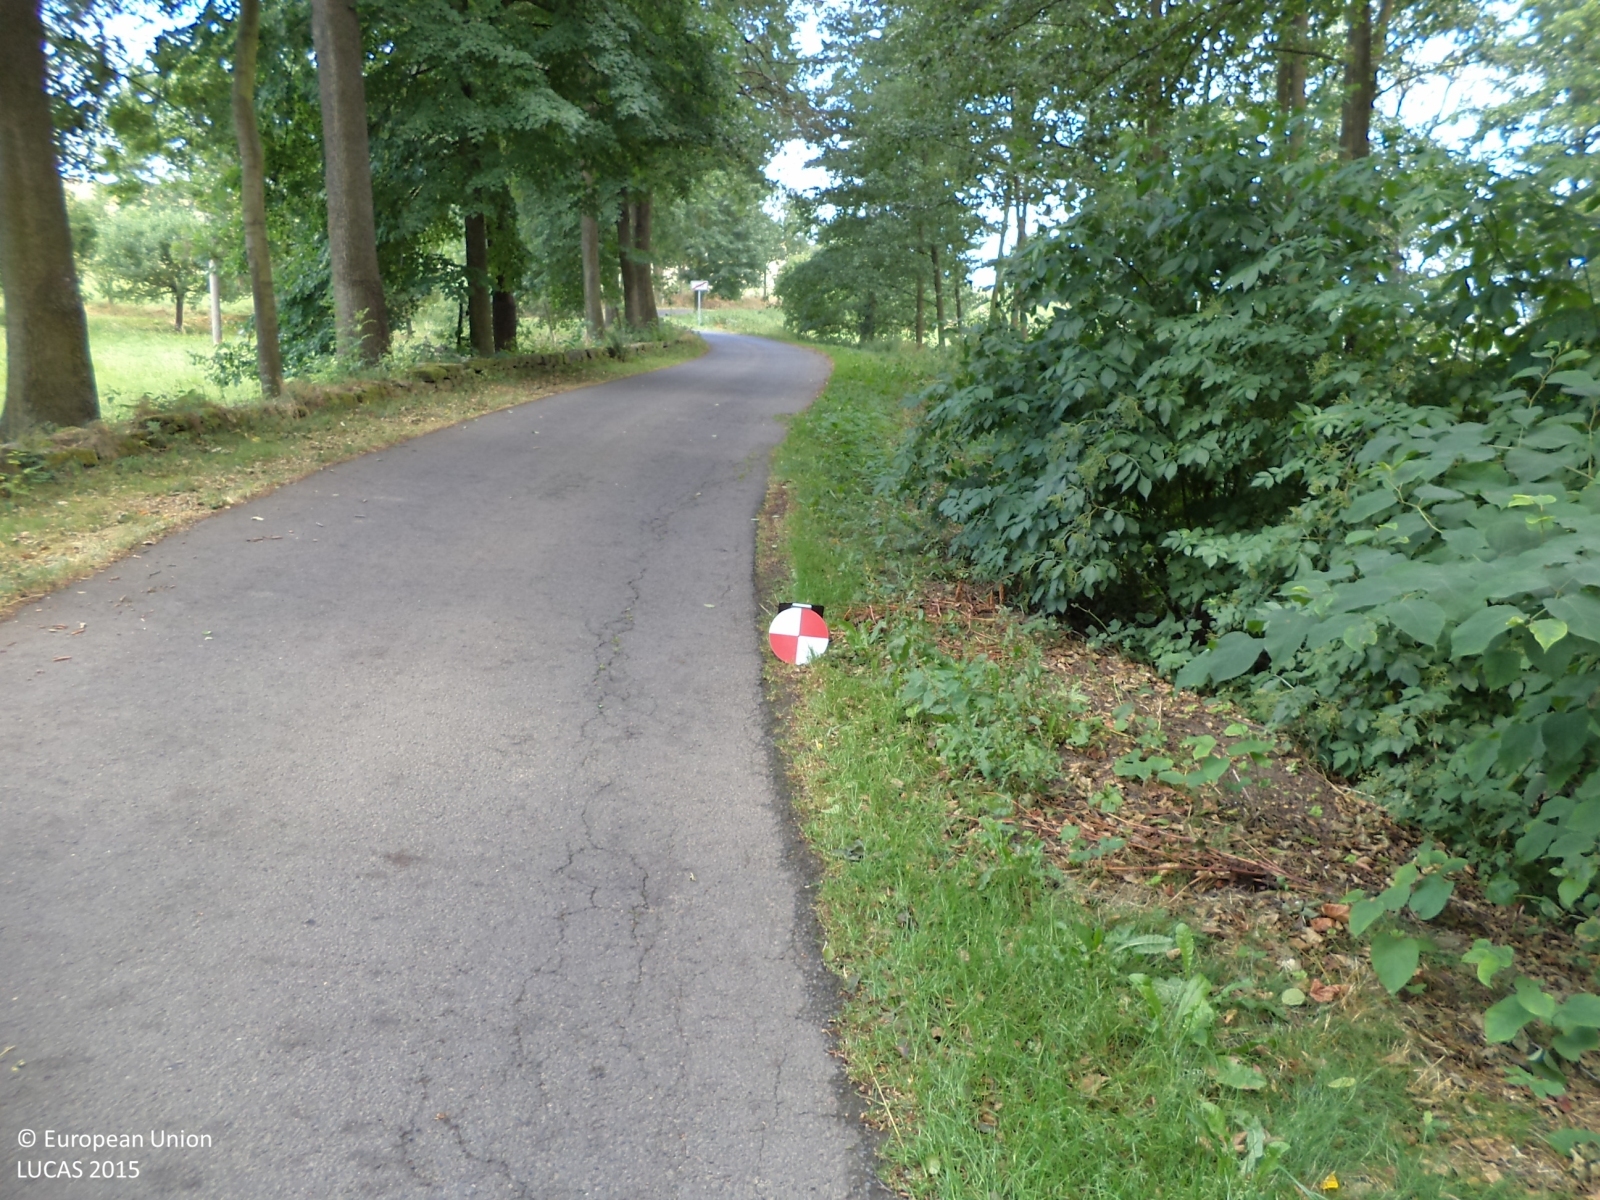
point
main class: Woodland
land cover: Broadleaved woodland
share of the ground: > 75 %
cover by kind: broadleaved forest trees 90 %, herbaceous plants 10 %
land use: Forestry
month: July
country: CZ
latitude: 49.6652
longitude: 14.4489
